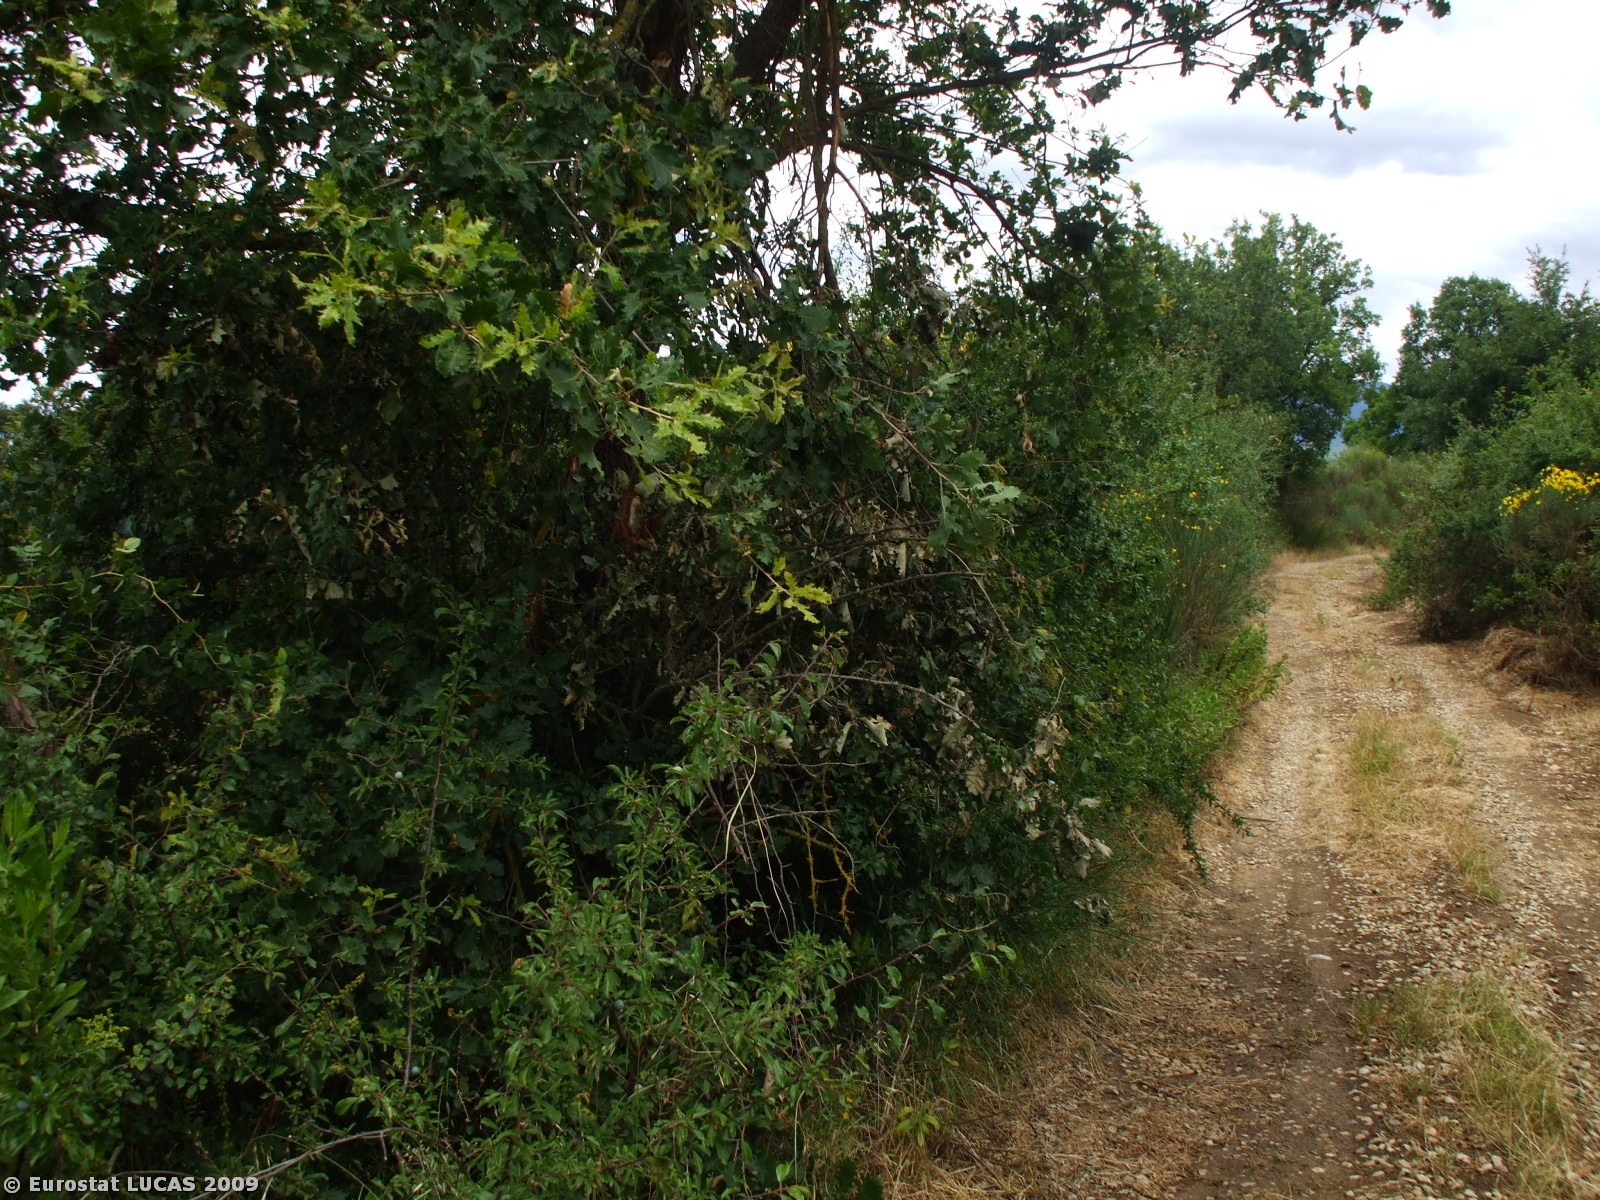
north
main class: Shrubland
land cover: Shrubland with sparse tree cover
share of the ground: > 75 %
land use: Unused
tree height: > 5 m
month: June
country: IT
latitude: 43.5251
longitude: 11.6658
